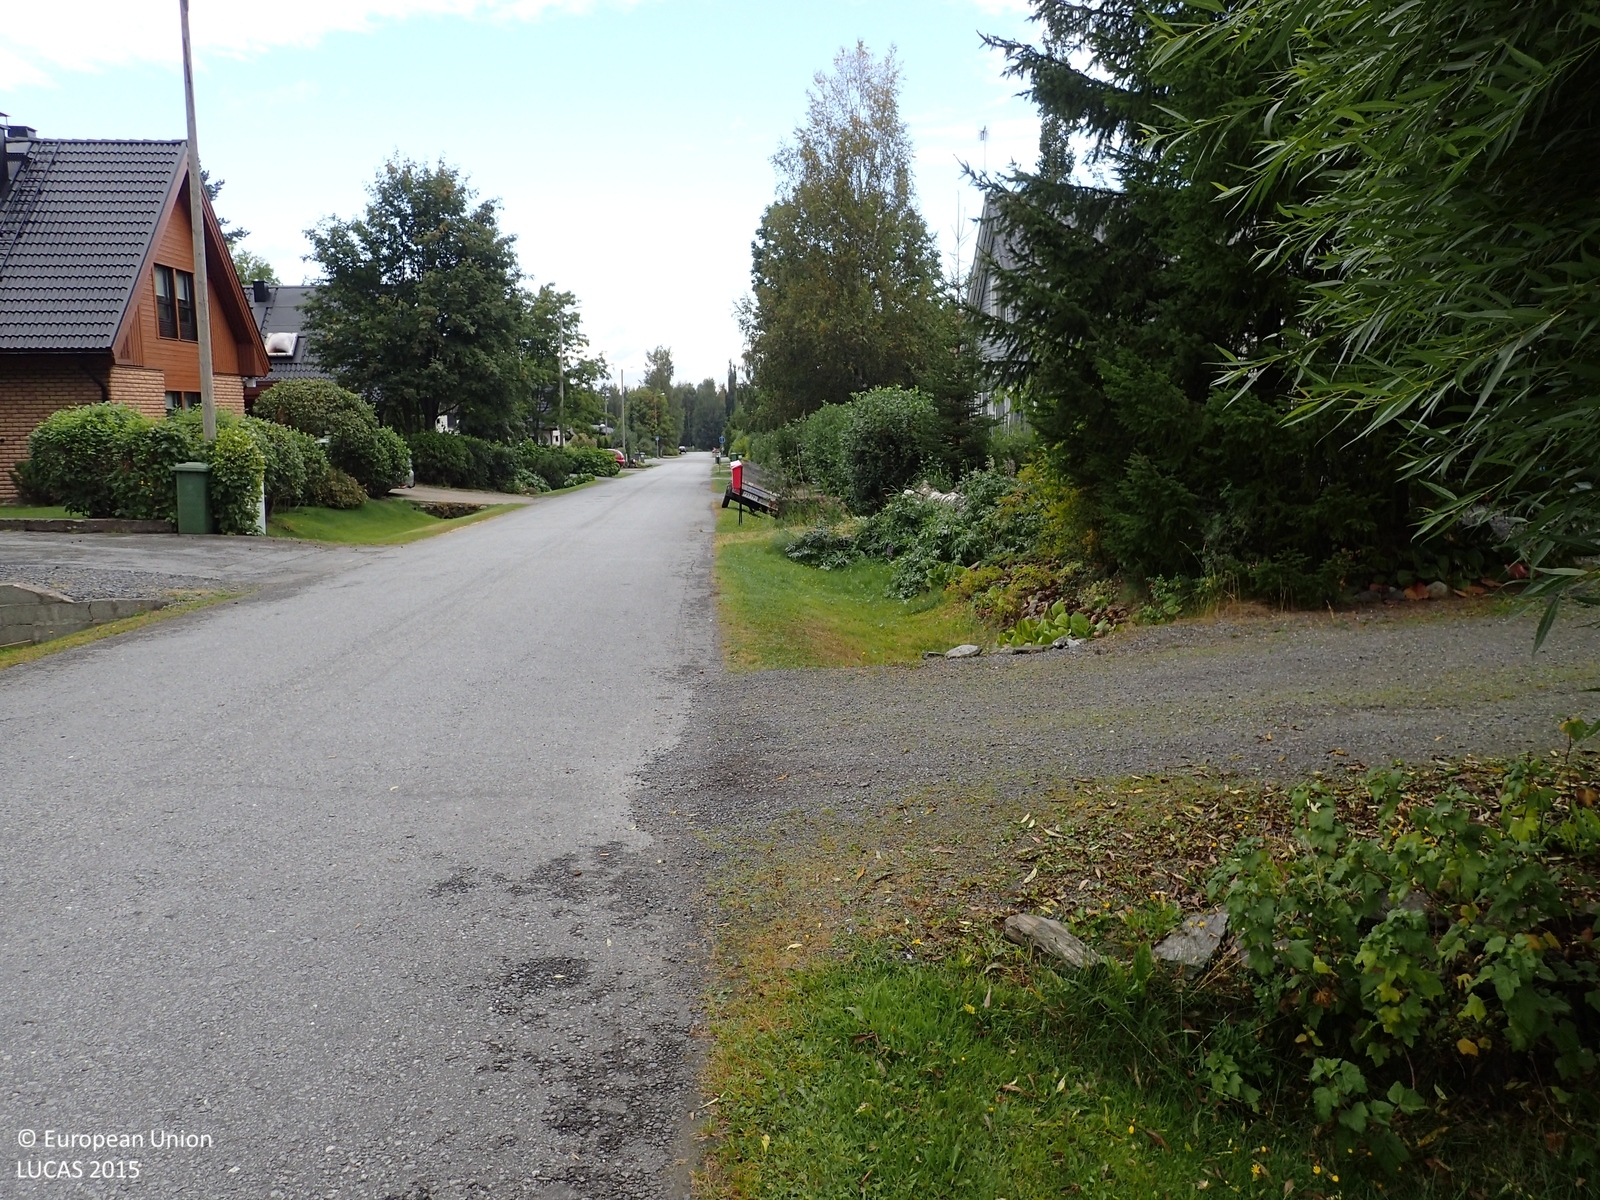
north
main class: Woodland
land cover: Broadleaved woodland
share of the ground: > 75 %
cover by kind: broadleaved forest trees 85 %, herbaceous plants 15 %
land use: Residential
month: August
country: FI
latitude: 62.7797
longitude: 22.7752
